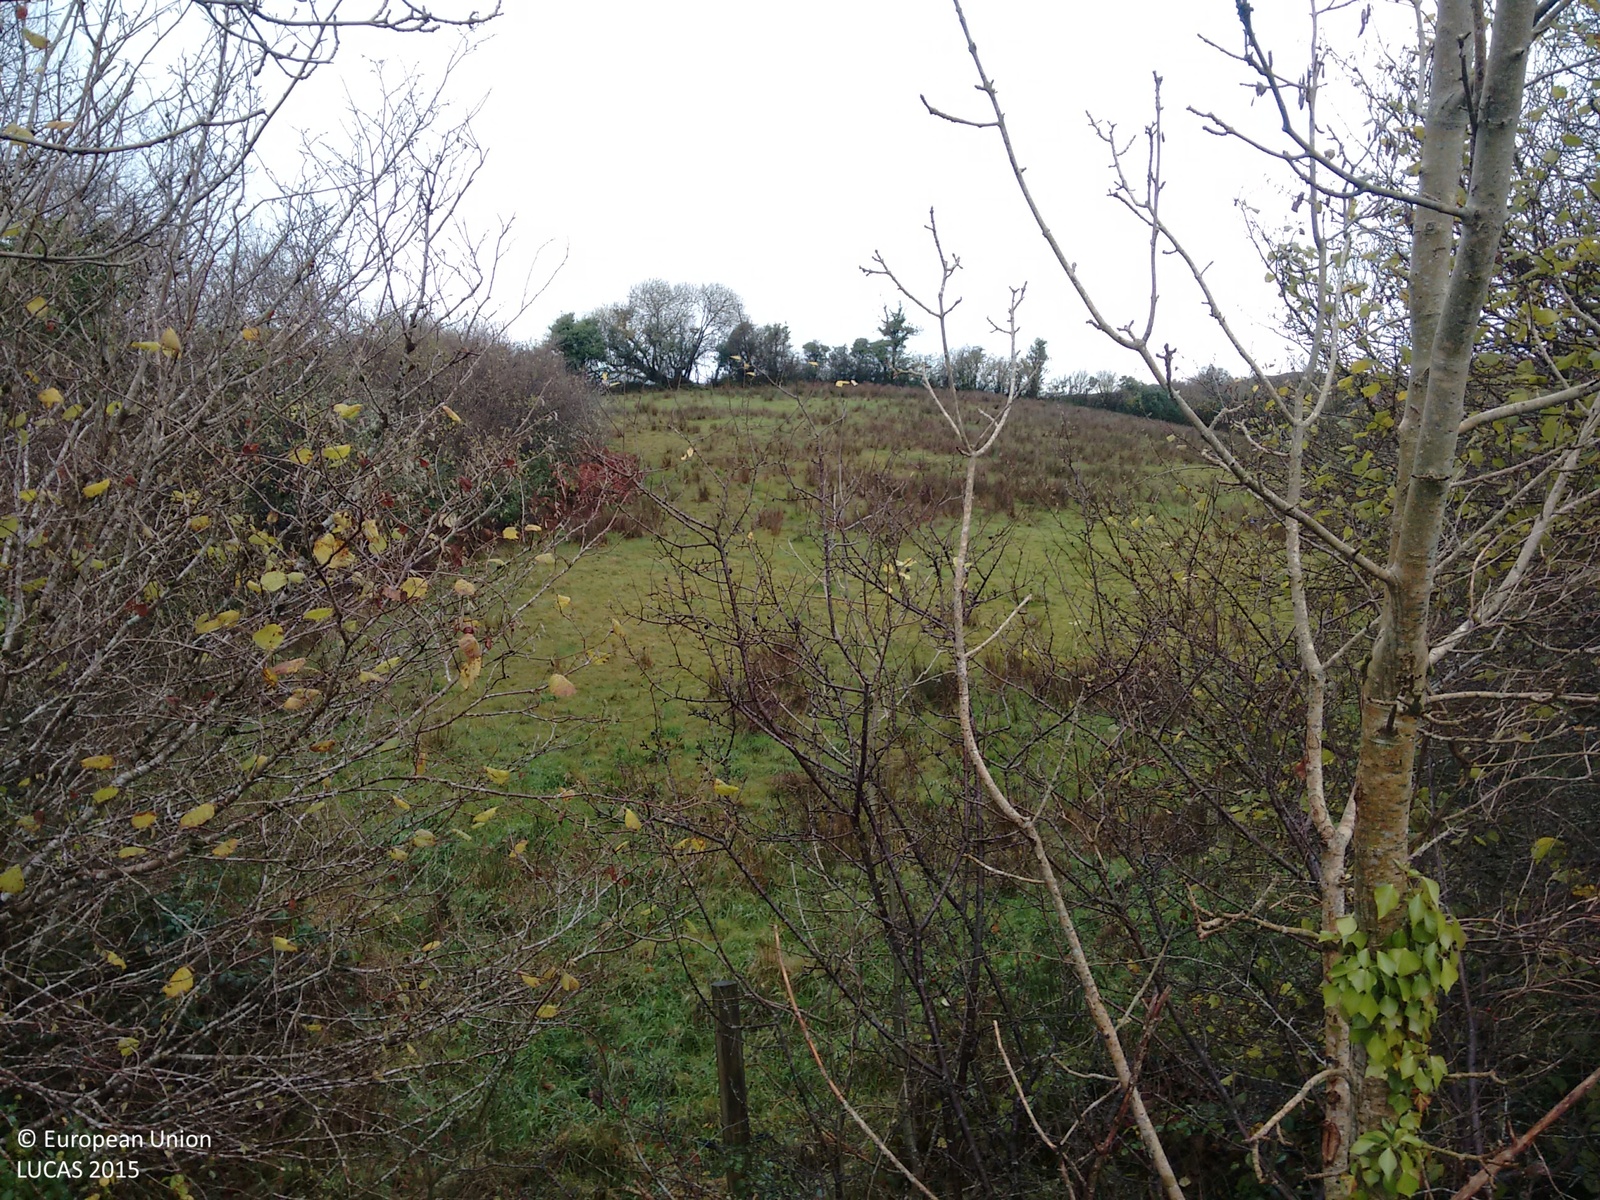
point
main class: Grassland
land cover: Grassland without tree/shrub cover
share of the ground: > 75 %
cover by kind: herbaceous plants 100 %
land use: Agriculture (excluding fallow land and kitchen gardens)
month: November
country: IE
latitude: 54.2160
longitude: -8.3589
